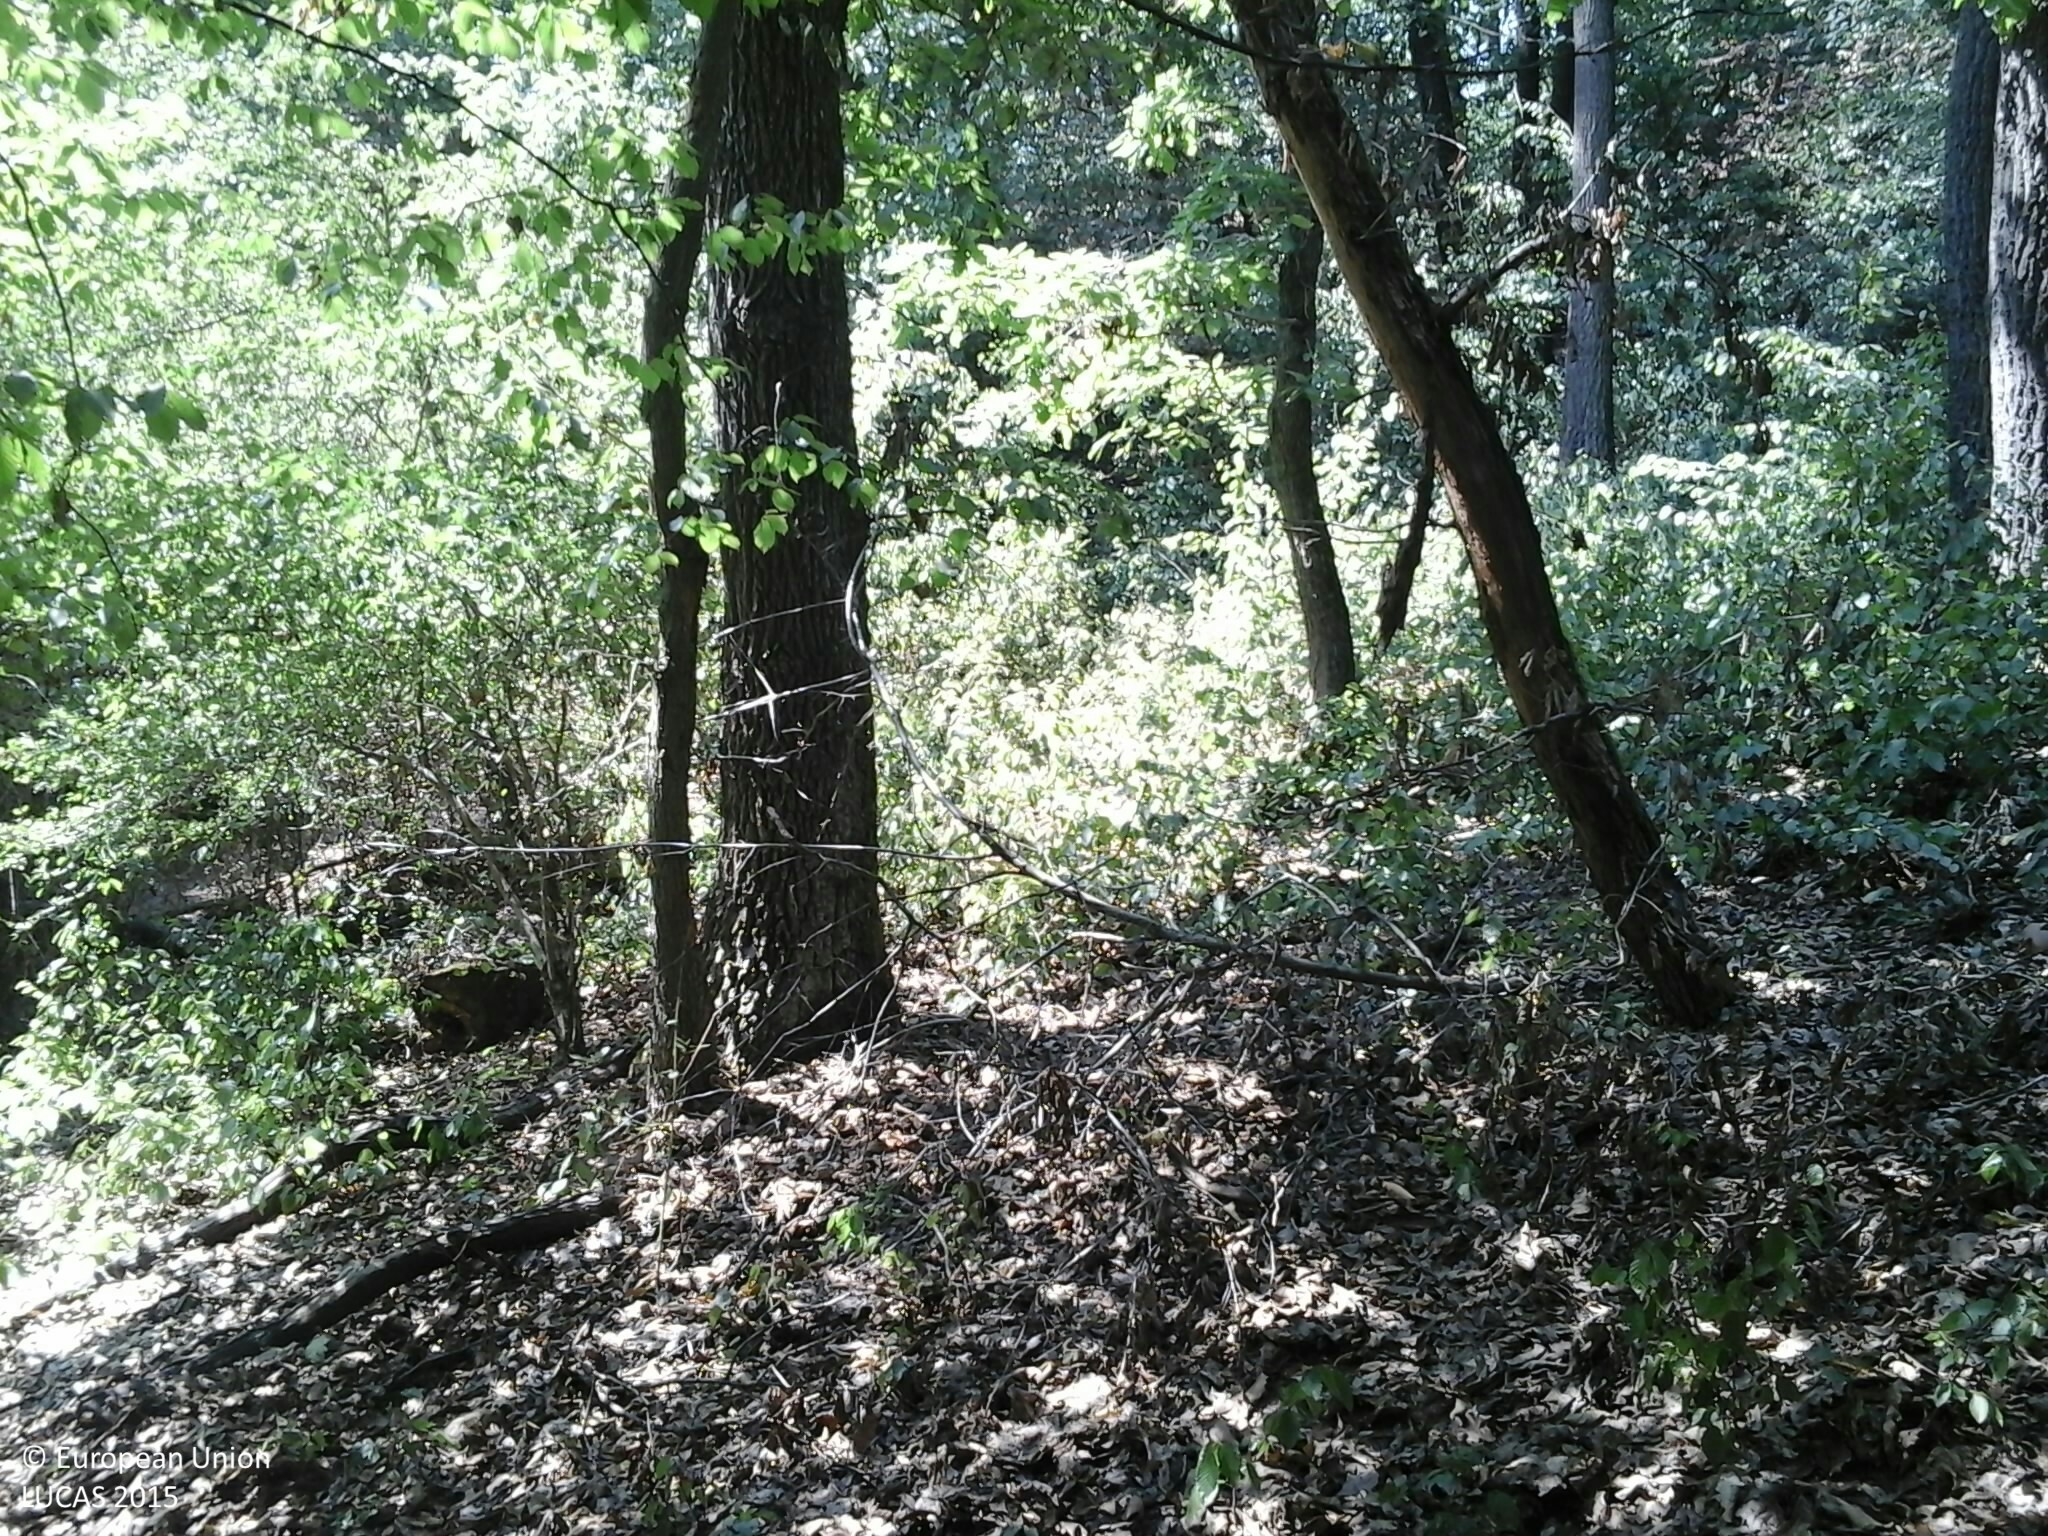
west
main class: Woodland
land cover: Broadleaved woodland
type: mesophytic deciduous forest
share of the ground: > 75 %
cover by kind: broadleaved forest trees 100 %
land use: Forestry
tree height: > 5 m
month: August
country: HU
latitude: 48.3208
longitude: 20.4860
